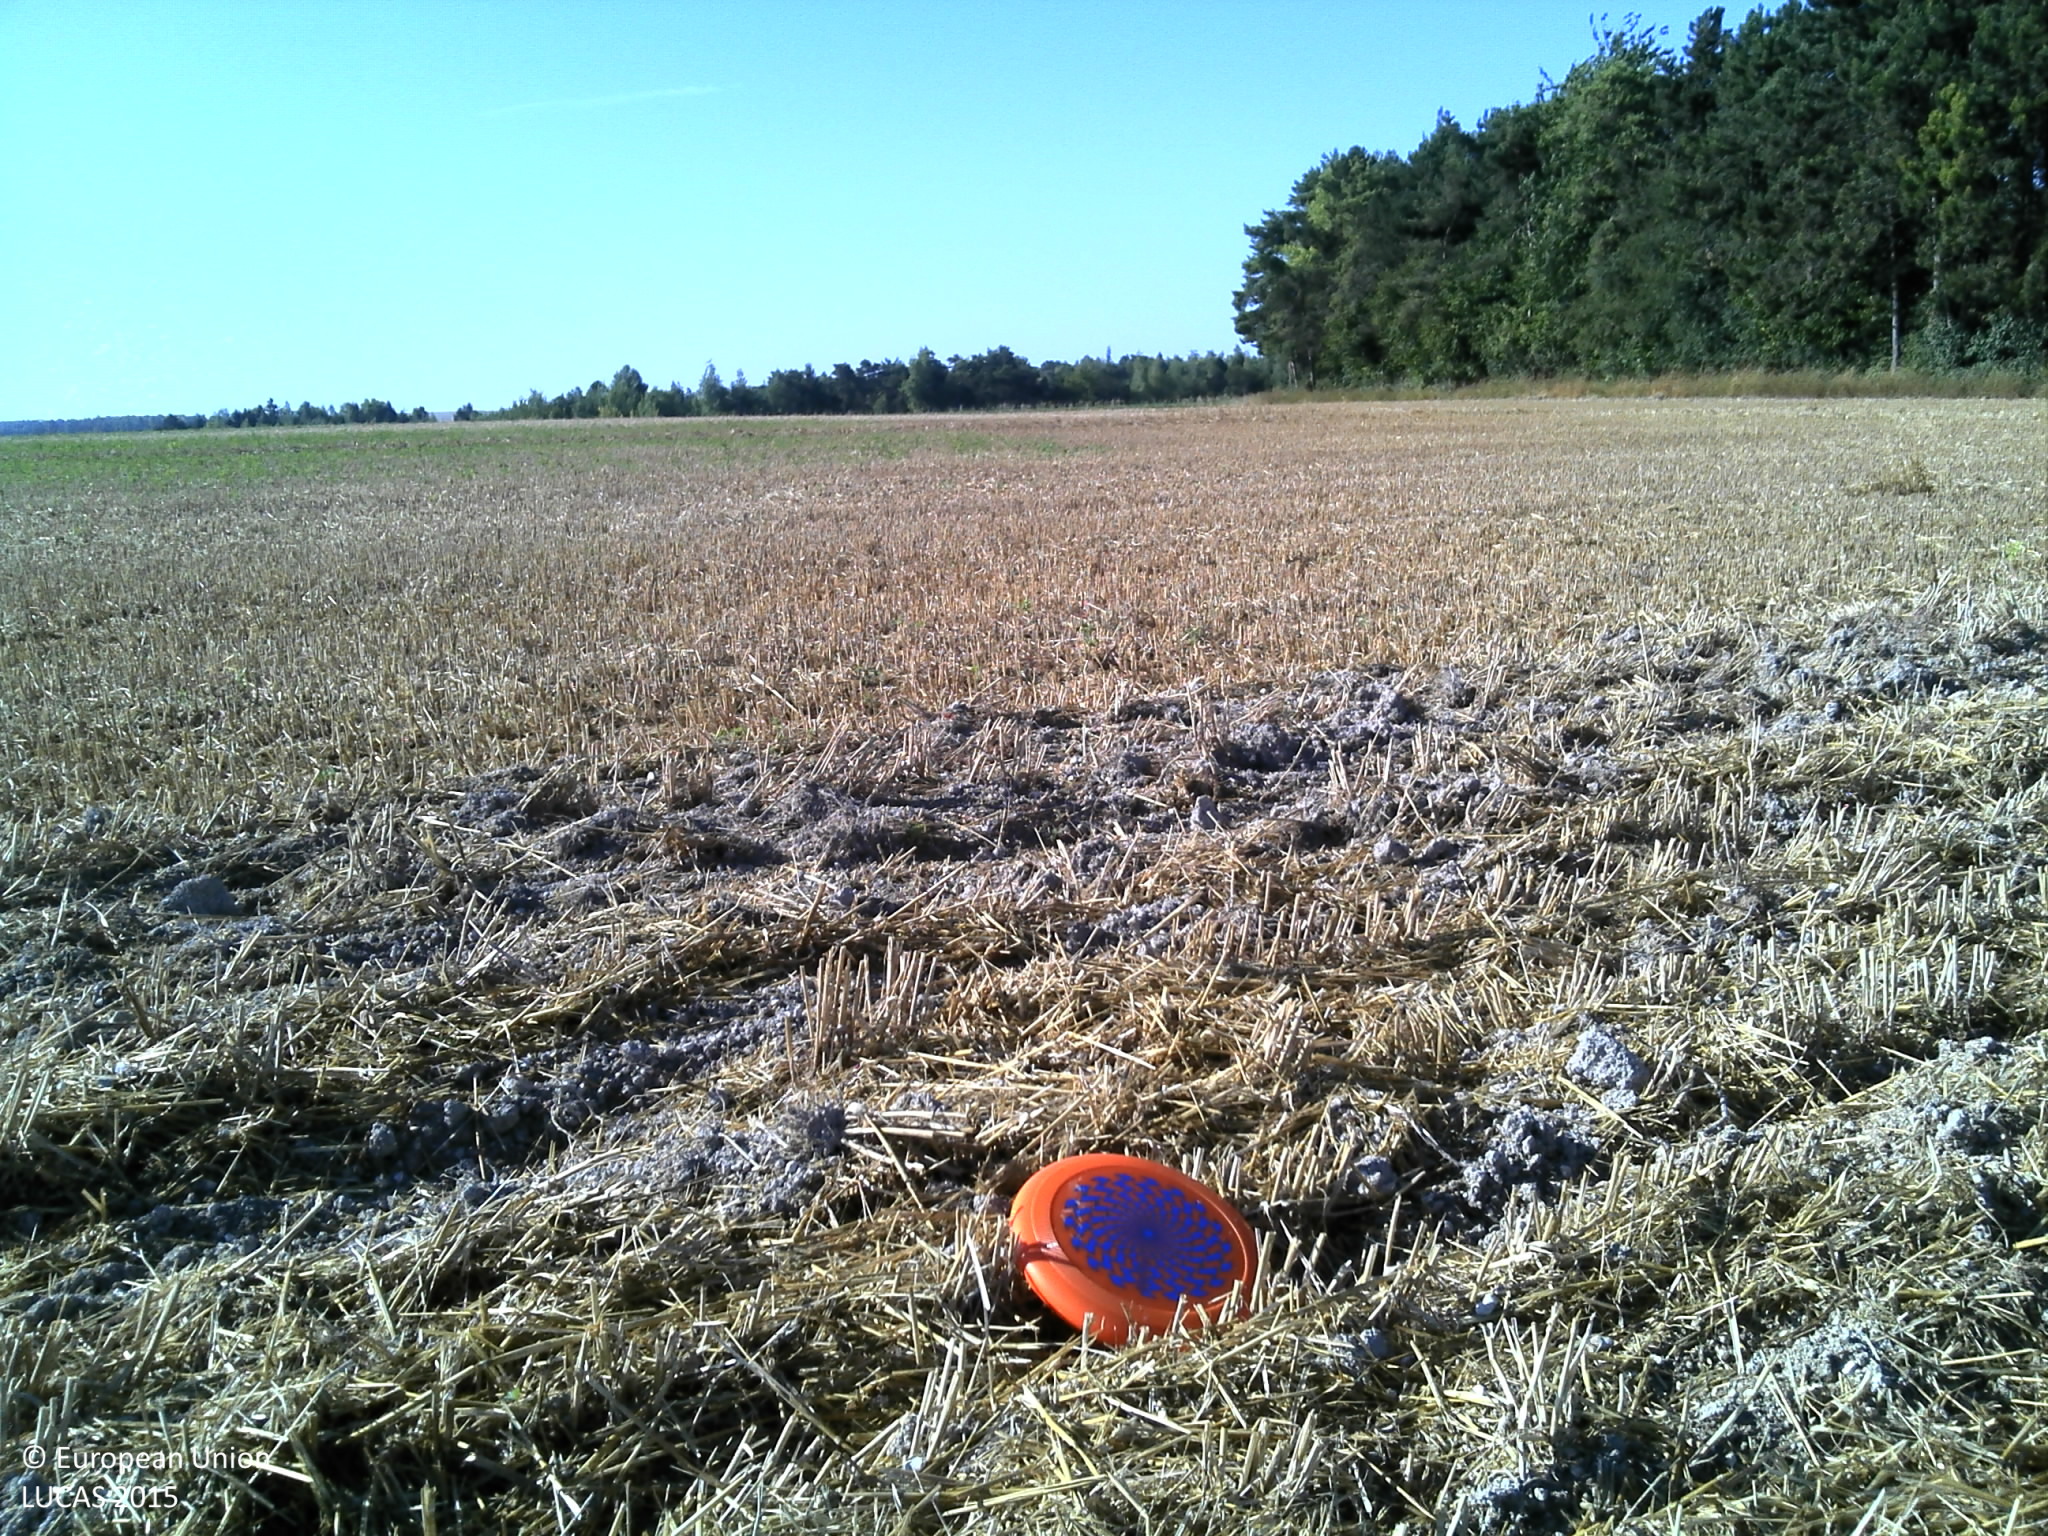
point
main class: Cropland
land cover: Barley
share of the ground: > 75 %
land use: Agriculture (excluding fallow land and kitchen gardens)
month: August
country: FR
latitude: 49.0876
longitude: 4.6979
